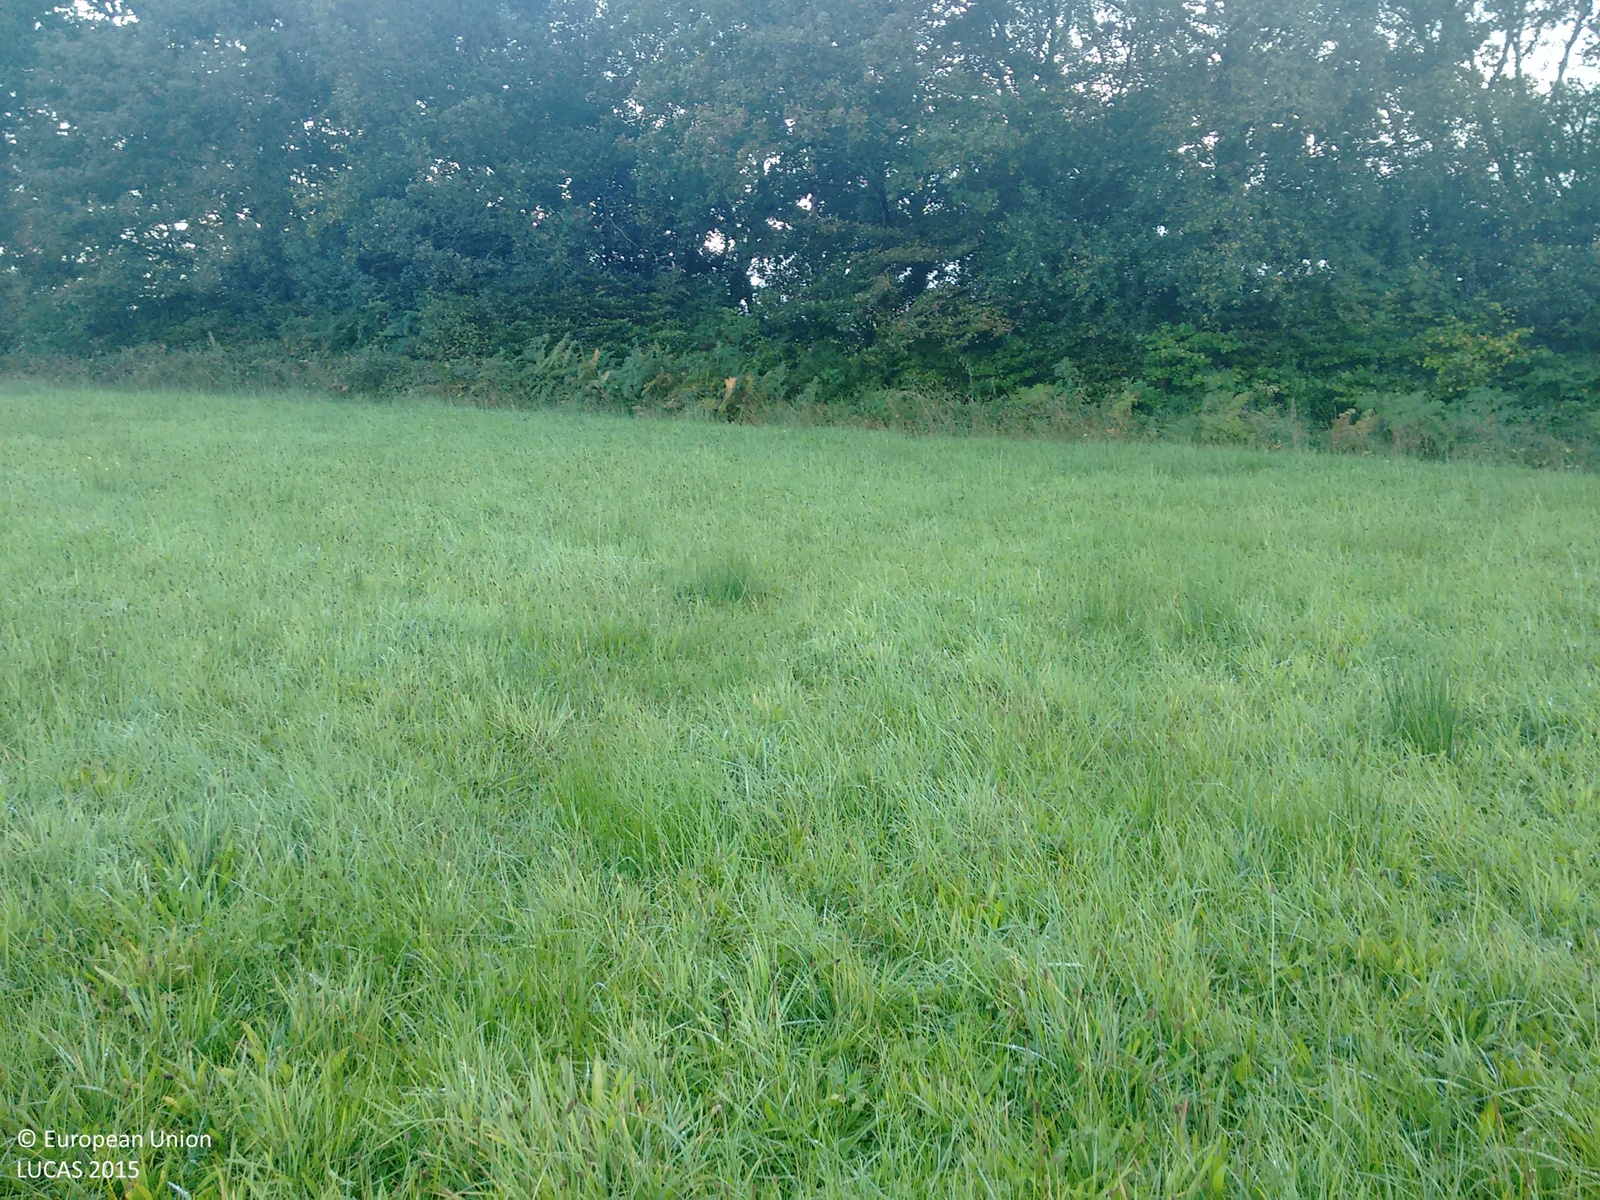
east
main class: Grassland
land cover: Grassland without tree/shrub cover
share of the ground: > 75 %
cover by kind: herbaceous plants 100 %
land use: Agriculture (excluding fallow land and kitchen gardens)
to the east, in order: Grassland without tree/shrub cover; Broadleaved woodland; Fences; Grassland without tree/shrub cover; Fences; Electric lines; Managed hedges; Paved roads, cycling and walking lanes; Grass margins; Managed hedges; Grassland without tree/shrub cover; Lines of trees; Managed hedges; Ditches and canals; Grass margins; Paved roads, cycling and walking lanes; Grass margins
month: September
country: GB
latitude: 50.7082
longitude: -4.1011
